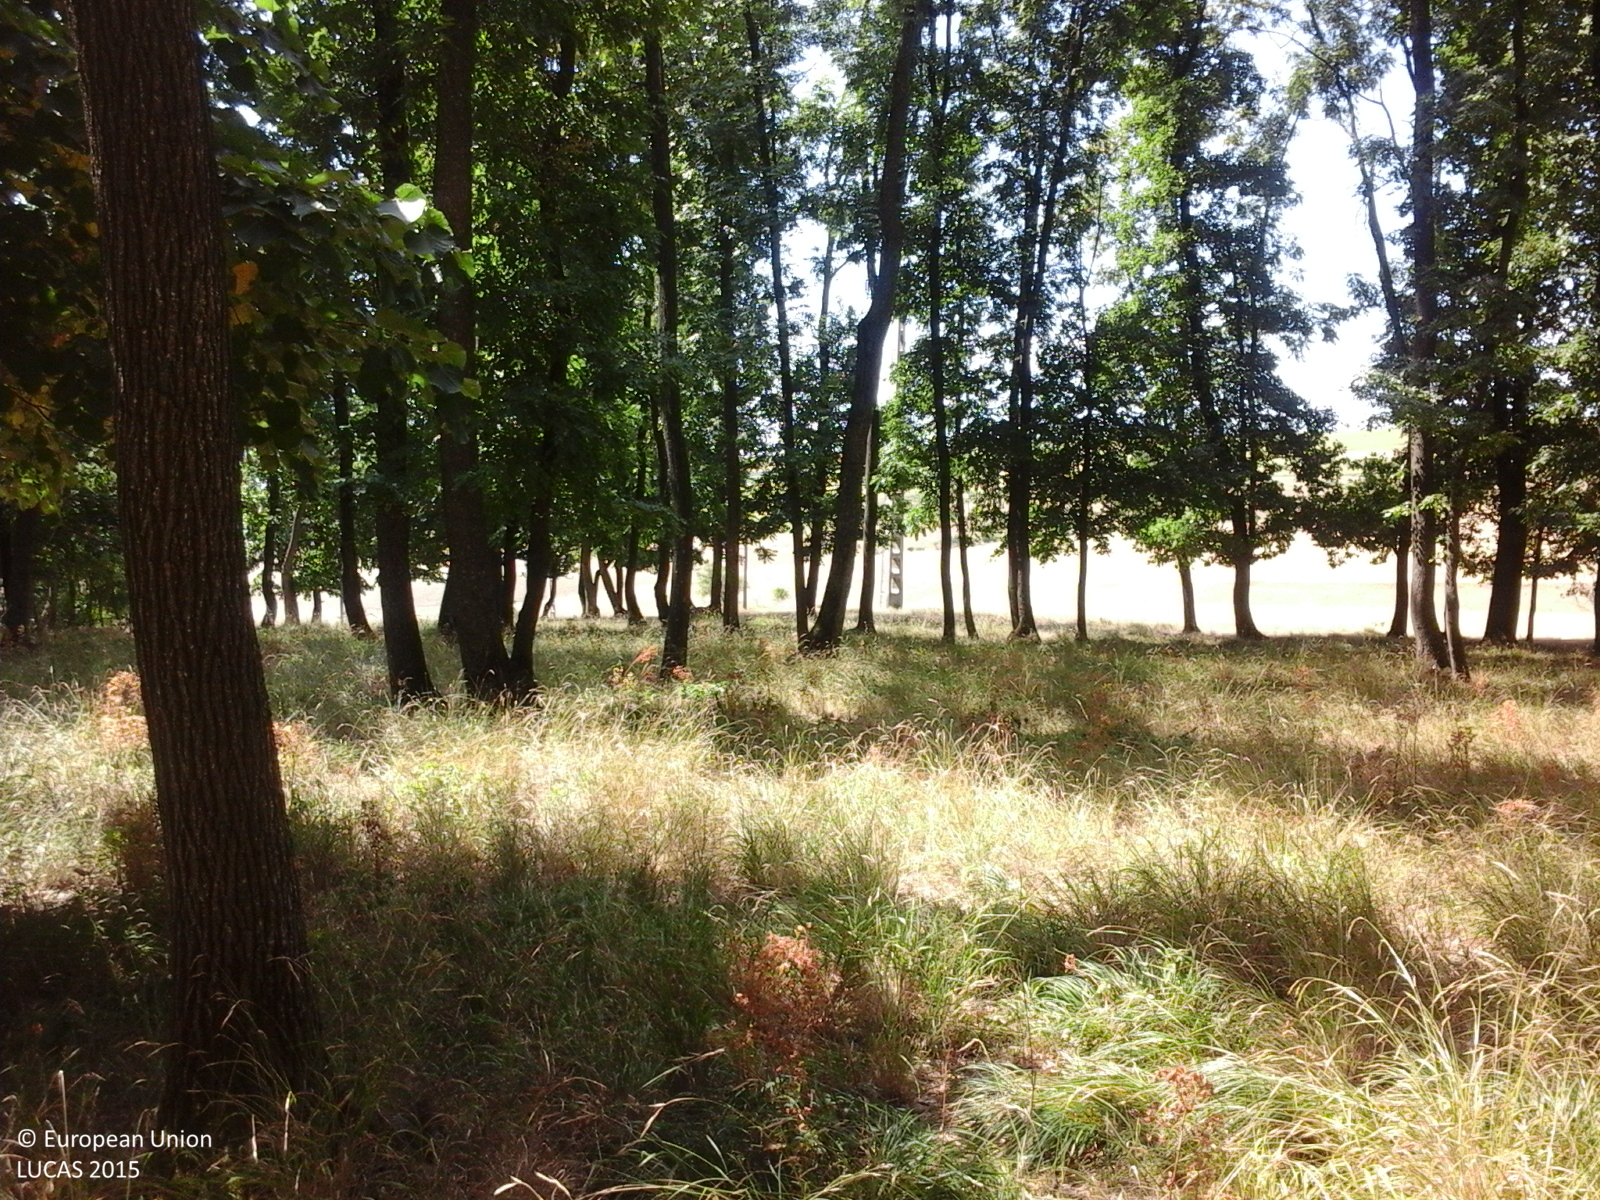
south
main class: Woodland
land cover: Broadleaved woodland
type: acidophilous oak and oak-birch forest
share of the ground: > 75 %
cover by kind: broadleaved forest trees 100 %
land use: Forestry
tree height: > 5 m
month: July
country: RO
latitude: 46.1222
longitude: 27.8608
